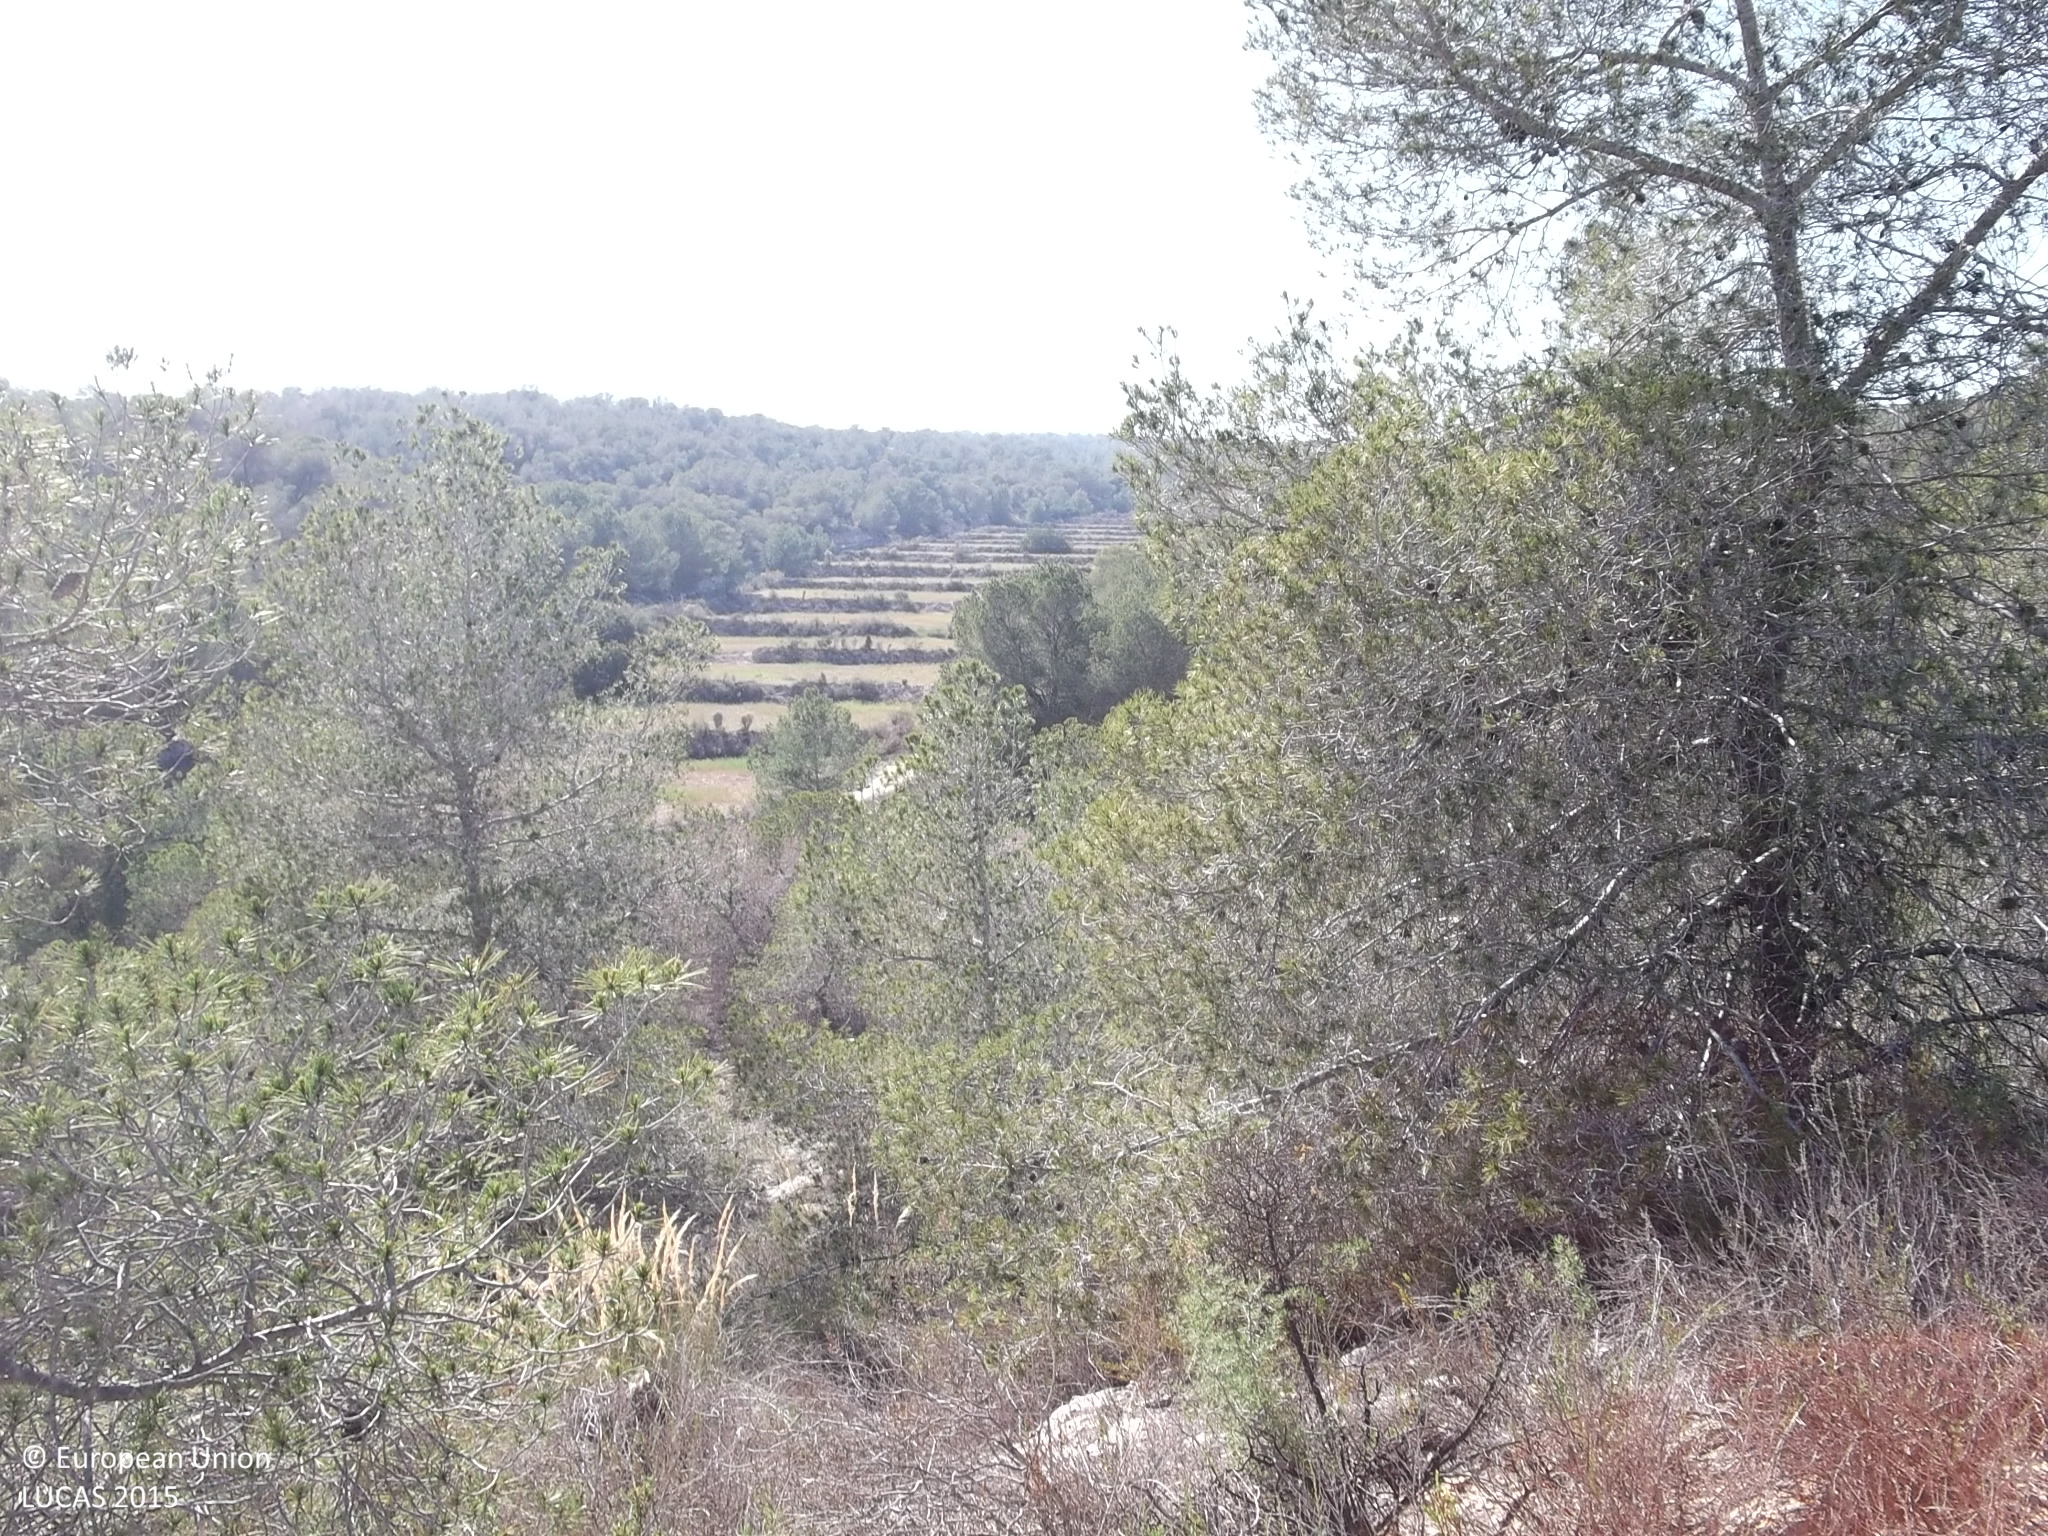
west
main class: Woodland
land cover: Pine dominated coniferous woodland
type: coniferous forest of the mediterranean region
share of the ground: 10 - 25 %
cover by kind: shrubs 30 %, consolidated bare surface 30 %, coniferous forest trees 20 %, herbaceous plants 20 %
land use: Semi-natural and natural areas not in use
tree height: > 5 m
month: May
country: ES
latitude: 37.9500
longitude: -0.8275
